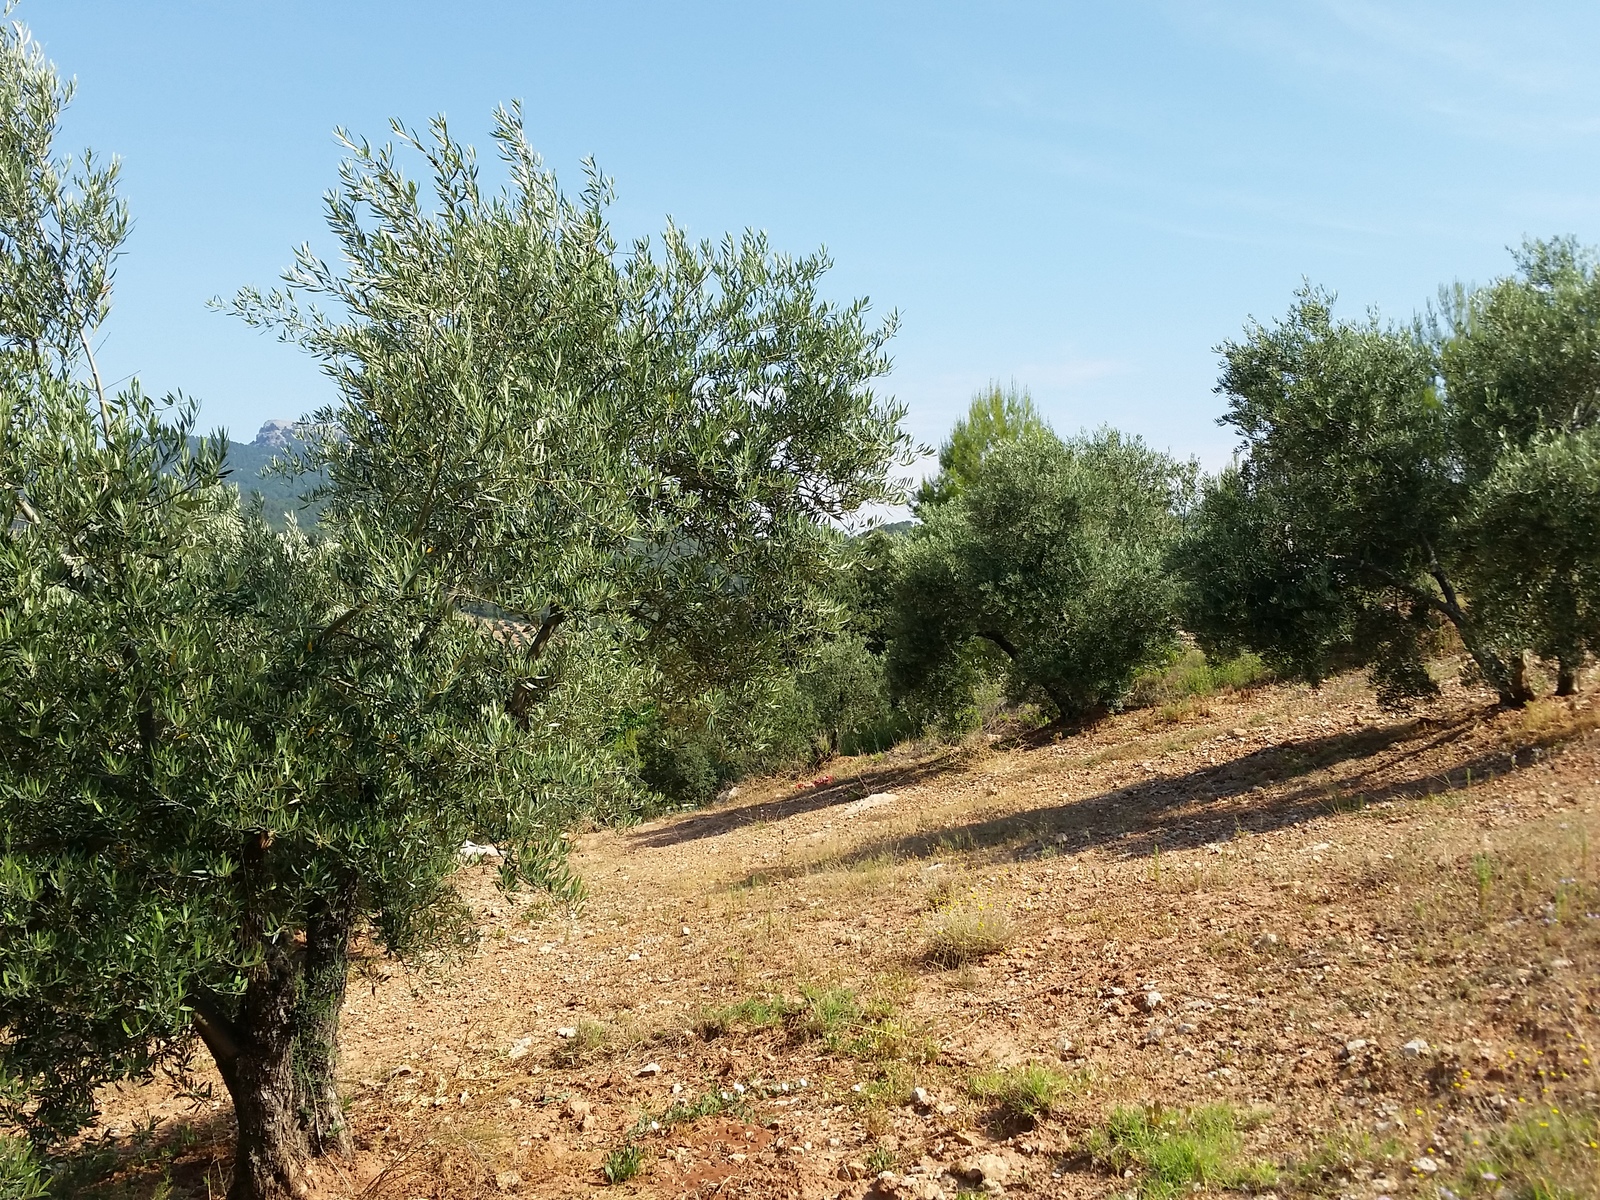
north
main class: Cropland
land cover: Olive groves
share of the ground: 50 - 75 %
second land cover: Grassland without tree/shrub cover
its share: 25 - 50 %
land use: Agriculture (excluding fallow land and kitchen gardens)
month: June
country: ES
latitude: 38.4163
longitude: -2.5394
